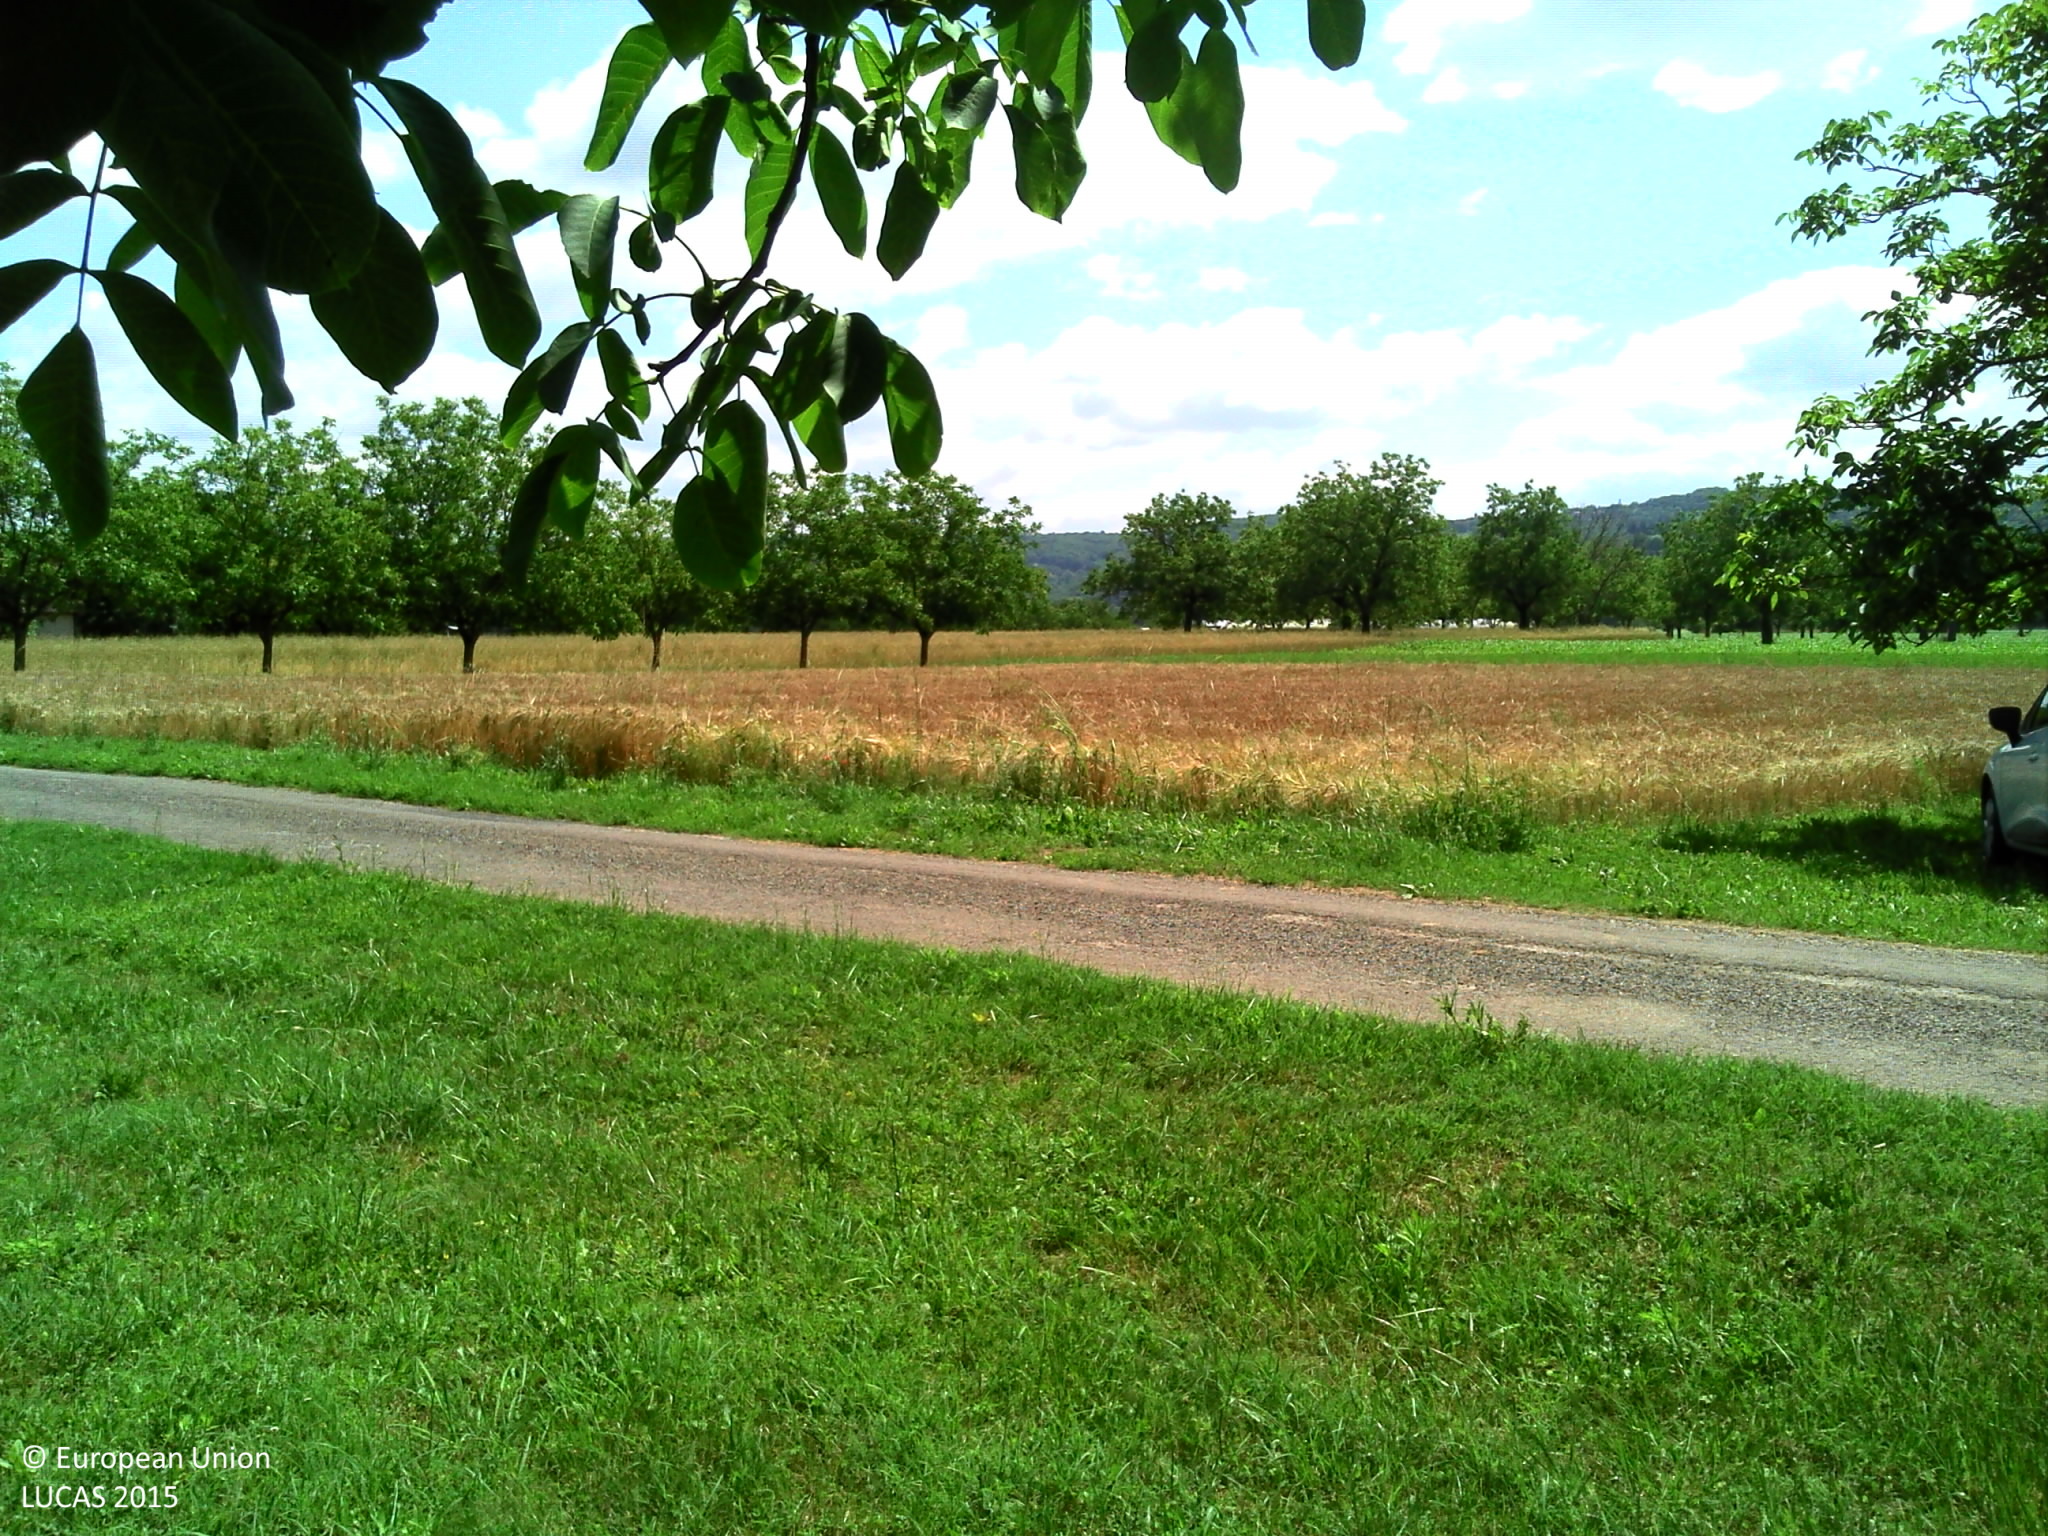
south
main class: Cropland
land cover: Nuts trees
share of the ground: 50 - 75 %
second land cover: Grassland without tree/shrub cover
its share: 10 - 25 %
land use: Agriculture (excluding fallow land and kitchen gardens)
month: June
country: FR
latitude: 44.9275
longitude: 1.7494
